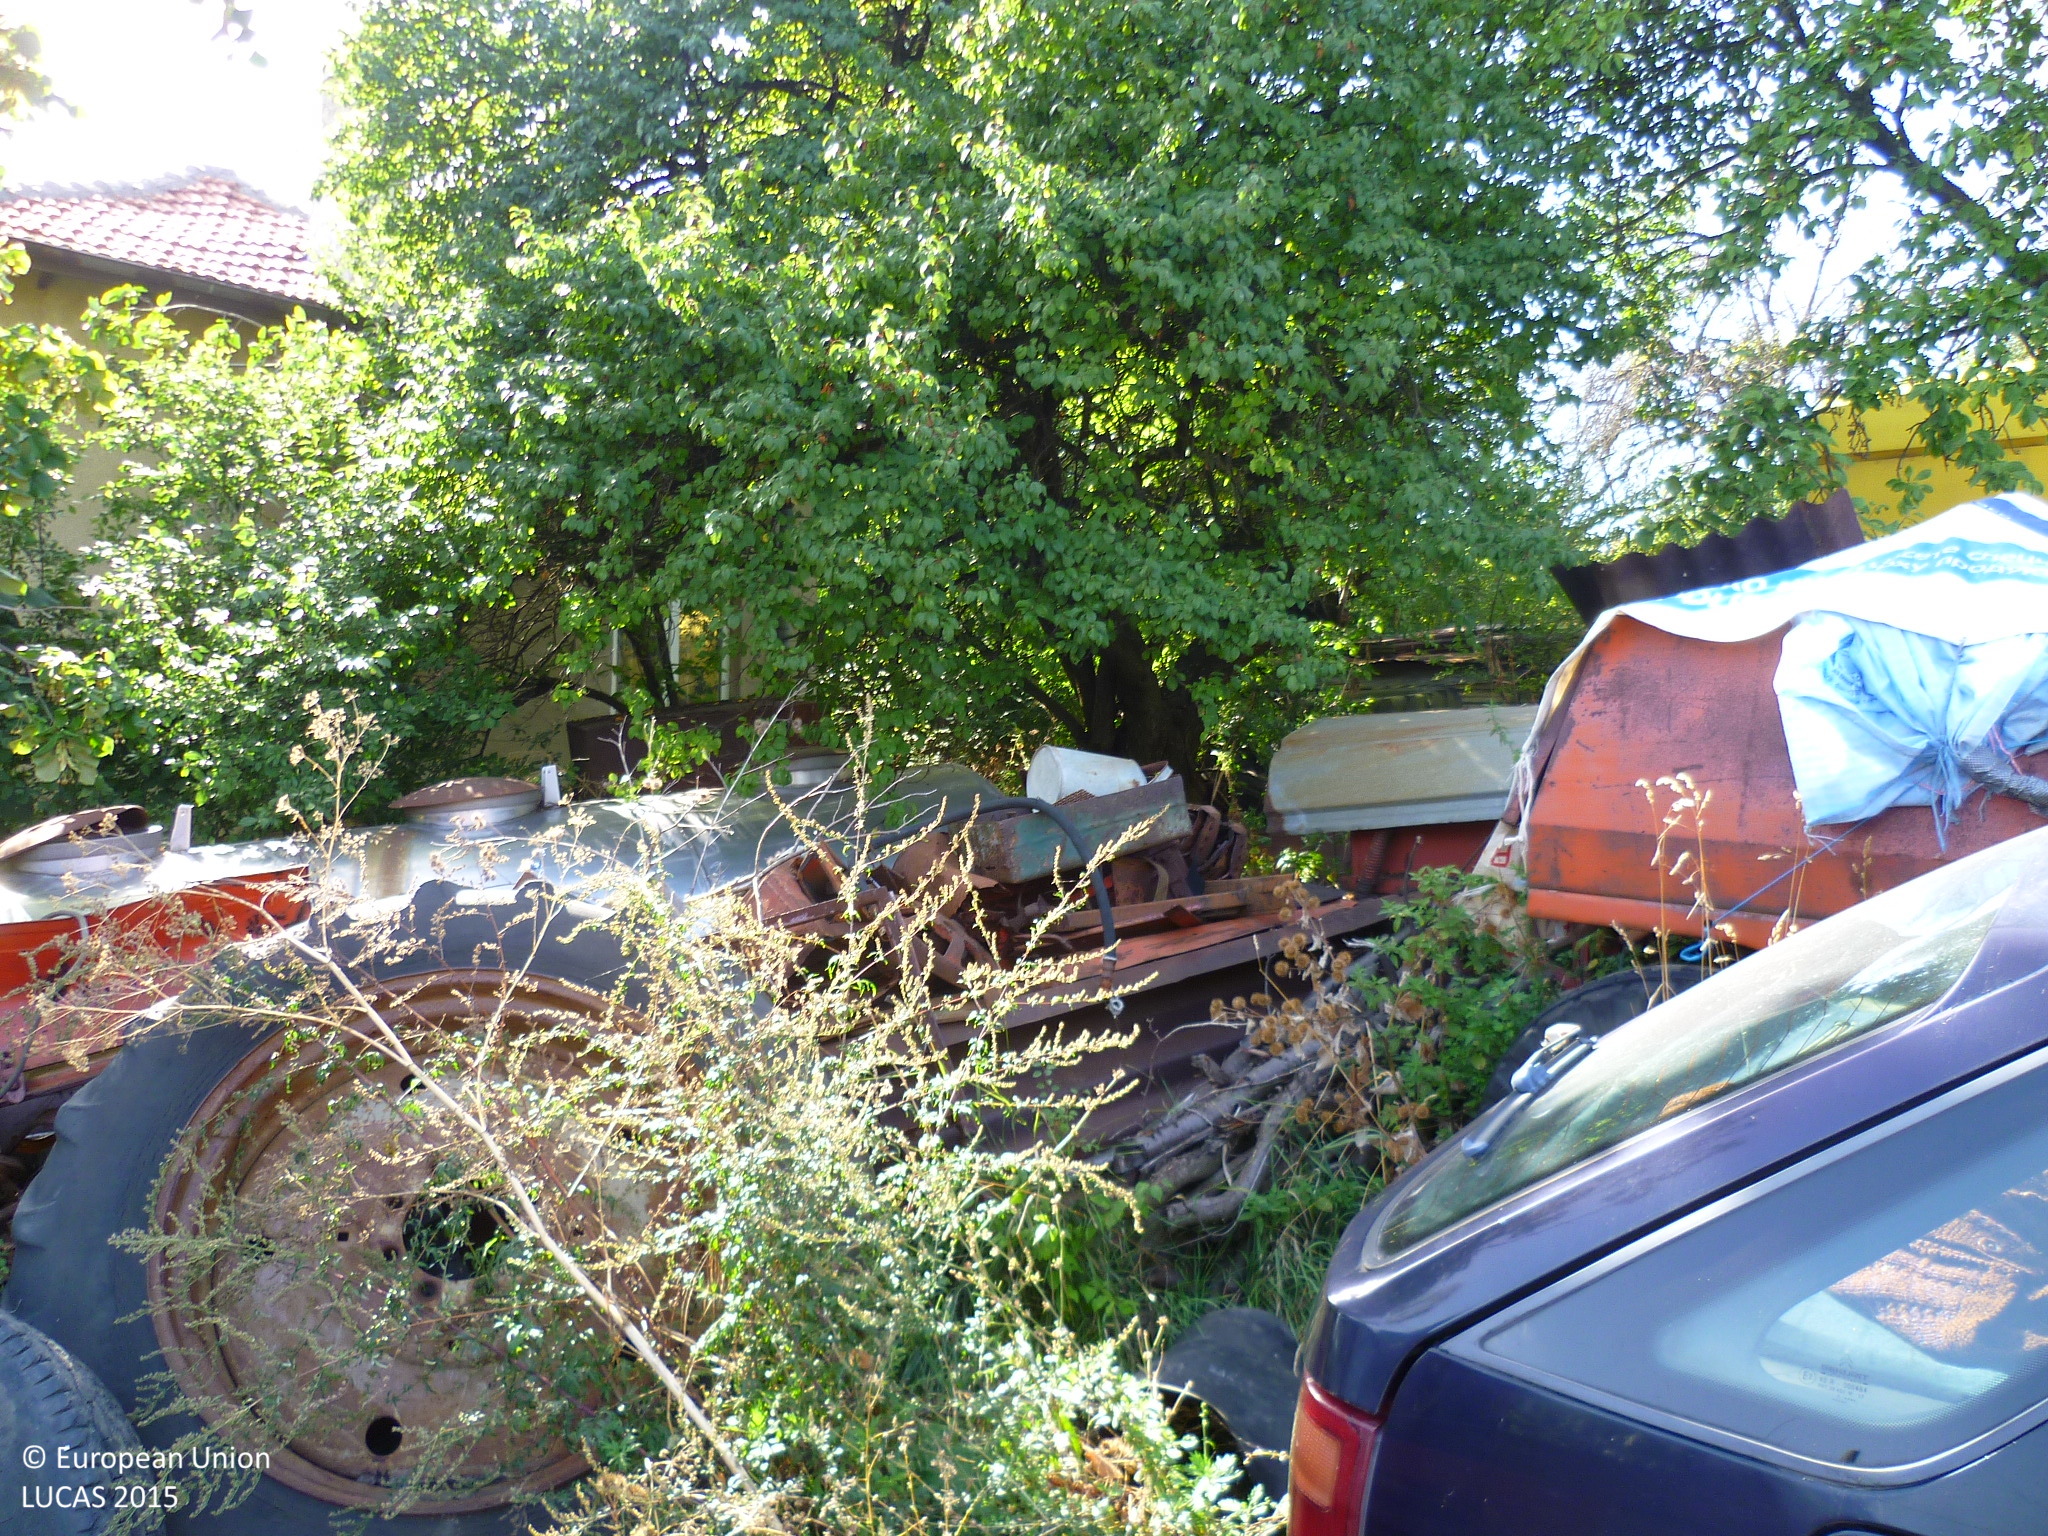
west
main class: Grassland
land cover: Grassland with sparse tree/shrub cover
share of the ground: 50 - 75 %
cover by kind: herbaceous plants 60 %, unconsolidated bare surface 30 %, broadleaved forest trees 5 %, shrubs 5 %
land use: Residential
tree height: > 5 m
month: September
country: BG
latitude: 42.6646
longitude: 23.0481
